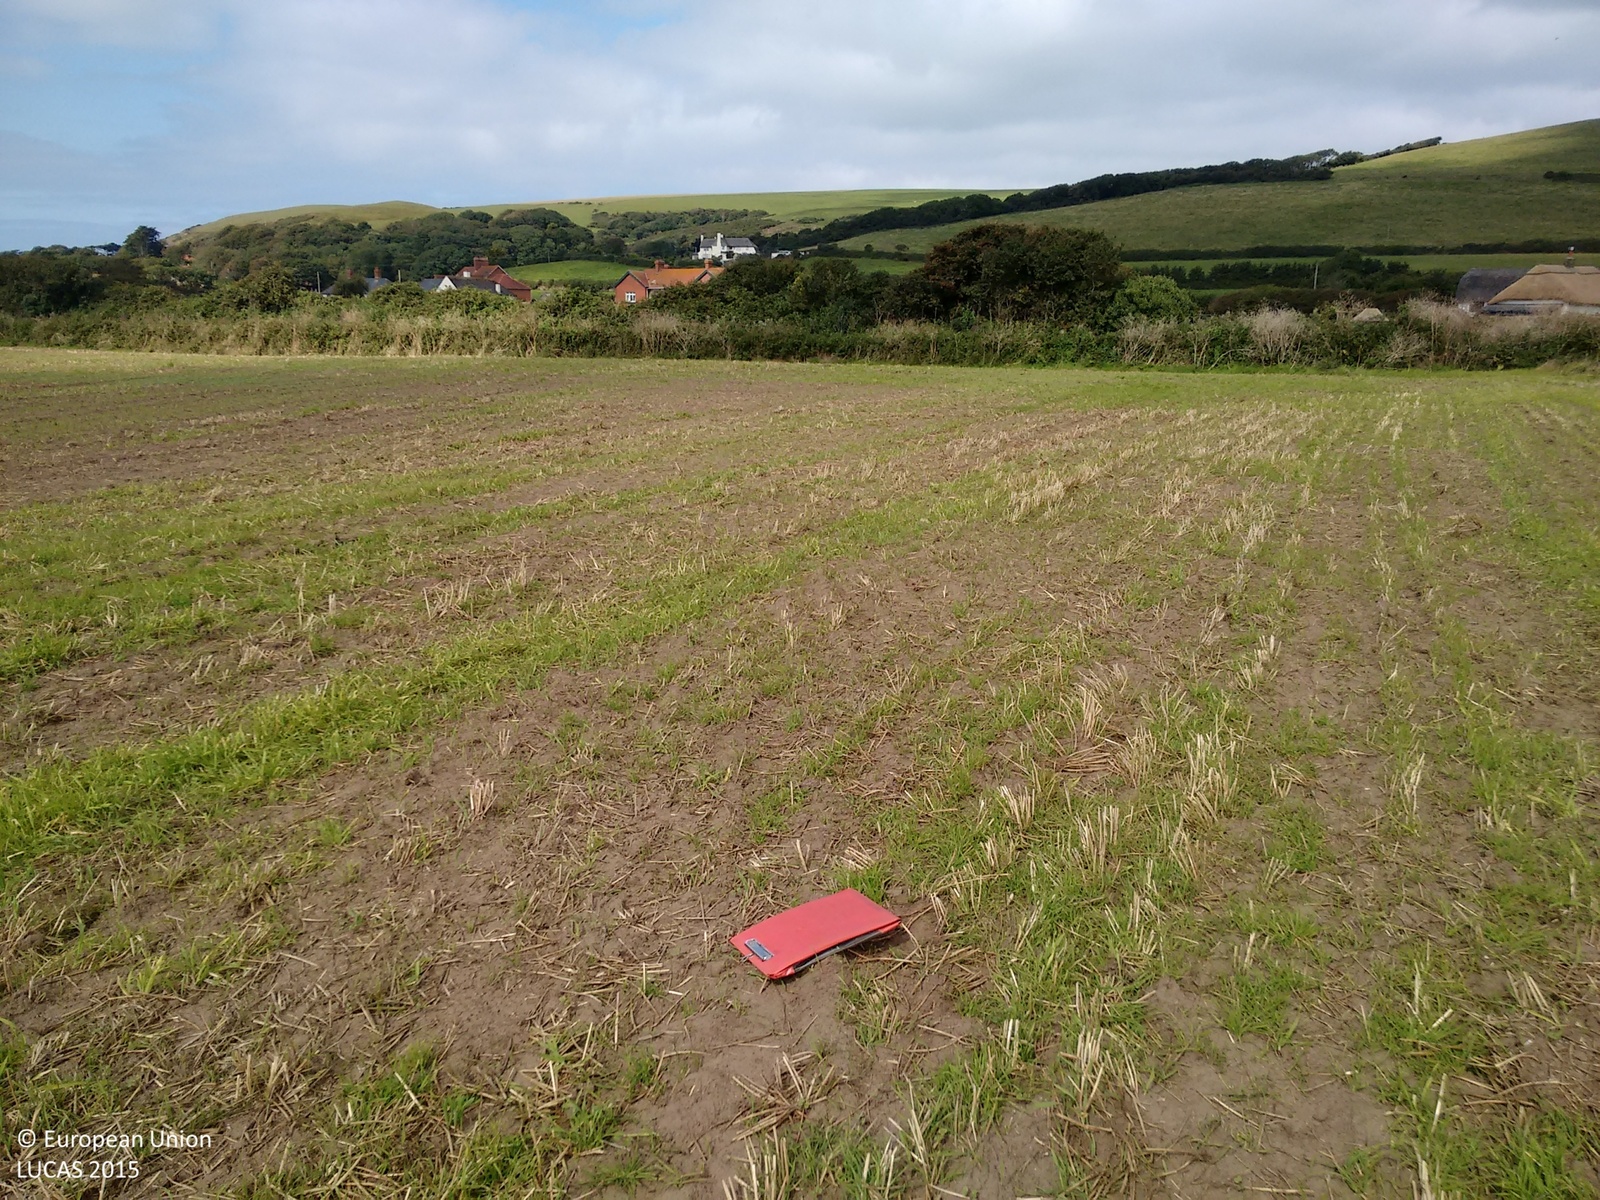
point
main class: Cropland
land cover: Barley
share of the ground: > 75 %
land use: Agriculture (excluding fallow land and kitchen gardens)
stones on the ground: < 10 %
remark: Harvested field
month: September
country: GB
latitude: 51.1163
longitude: -4.1983
